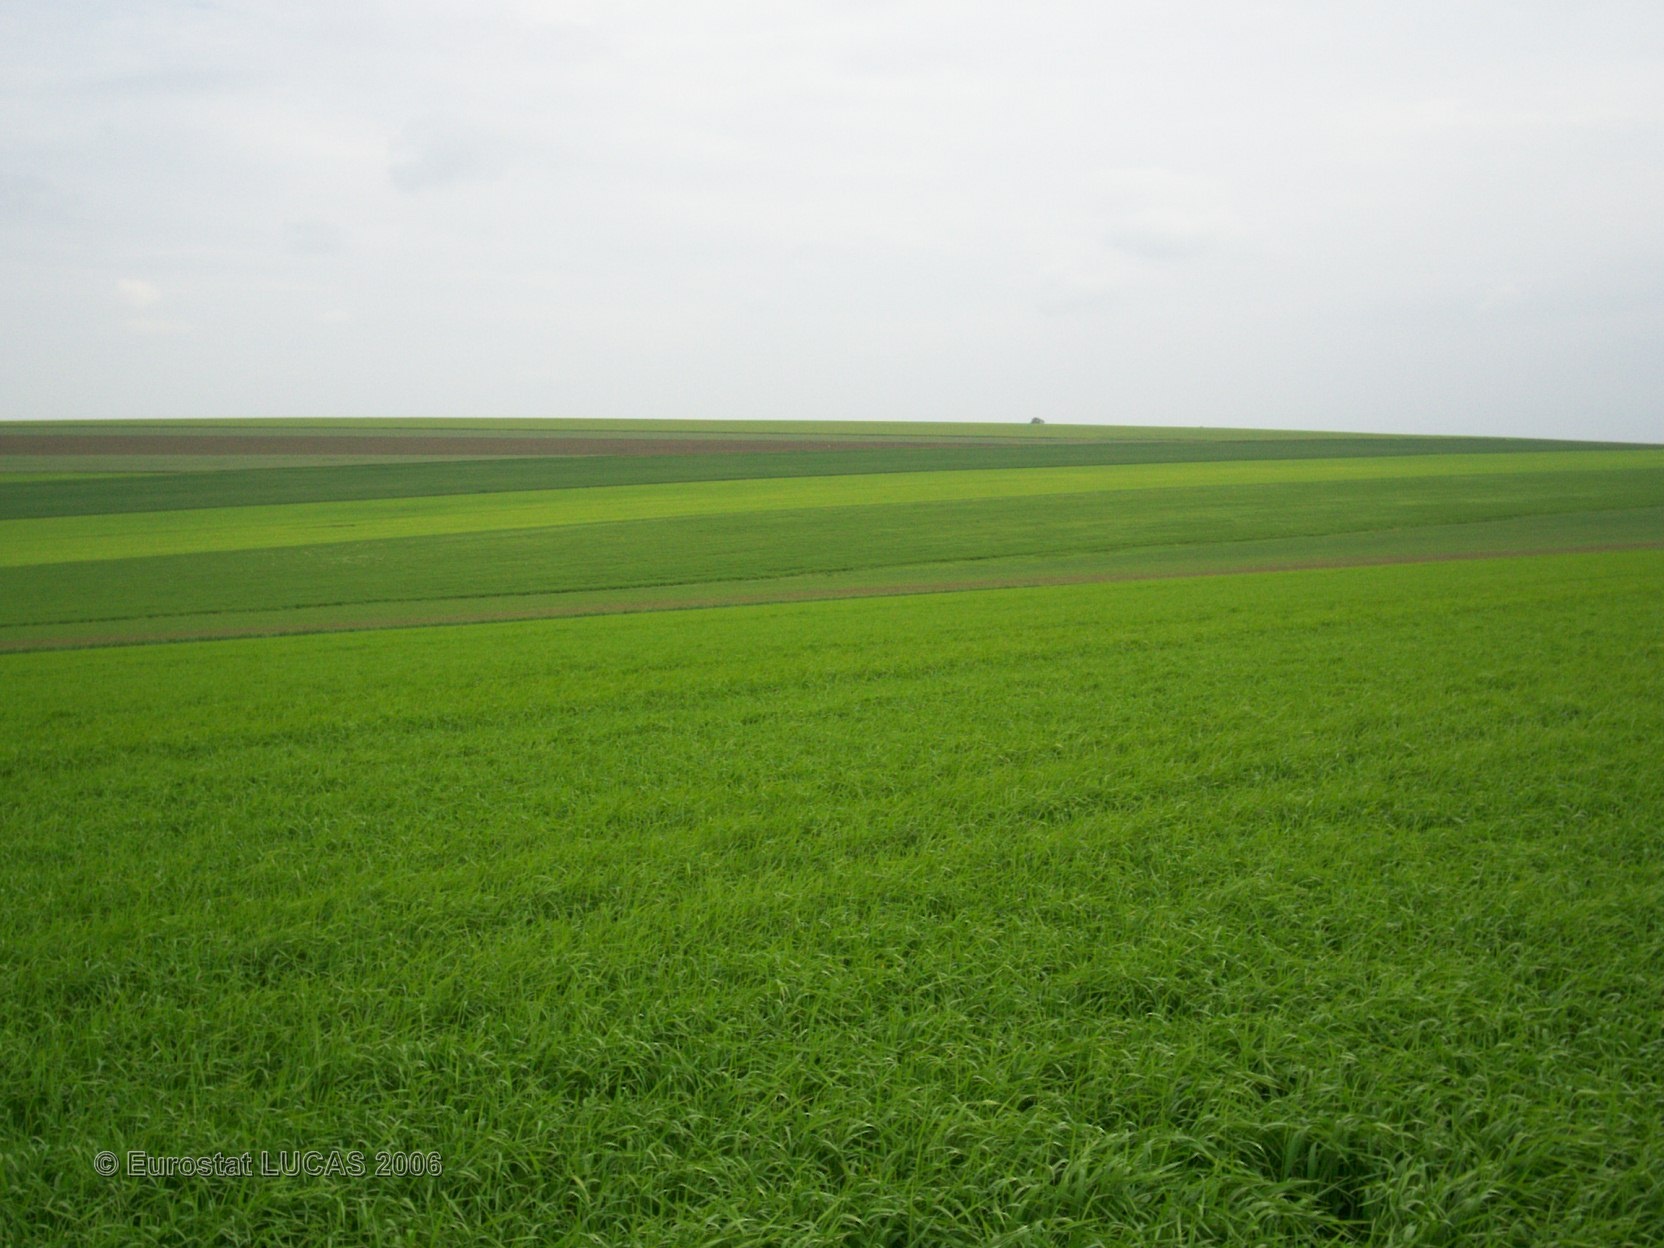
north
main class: Cropland
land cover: Barley
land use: Agriculture (excluding fallow land and kitchen gardens)
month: June
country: FR
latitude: 48.7309
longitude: 4.4089
